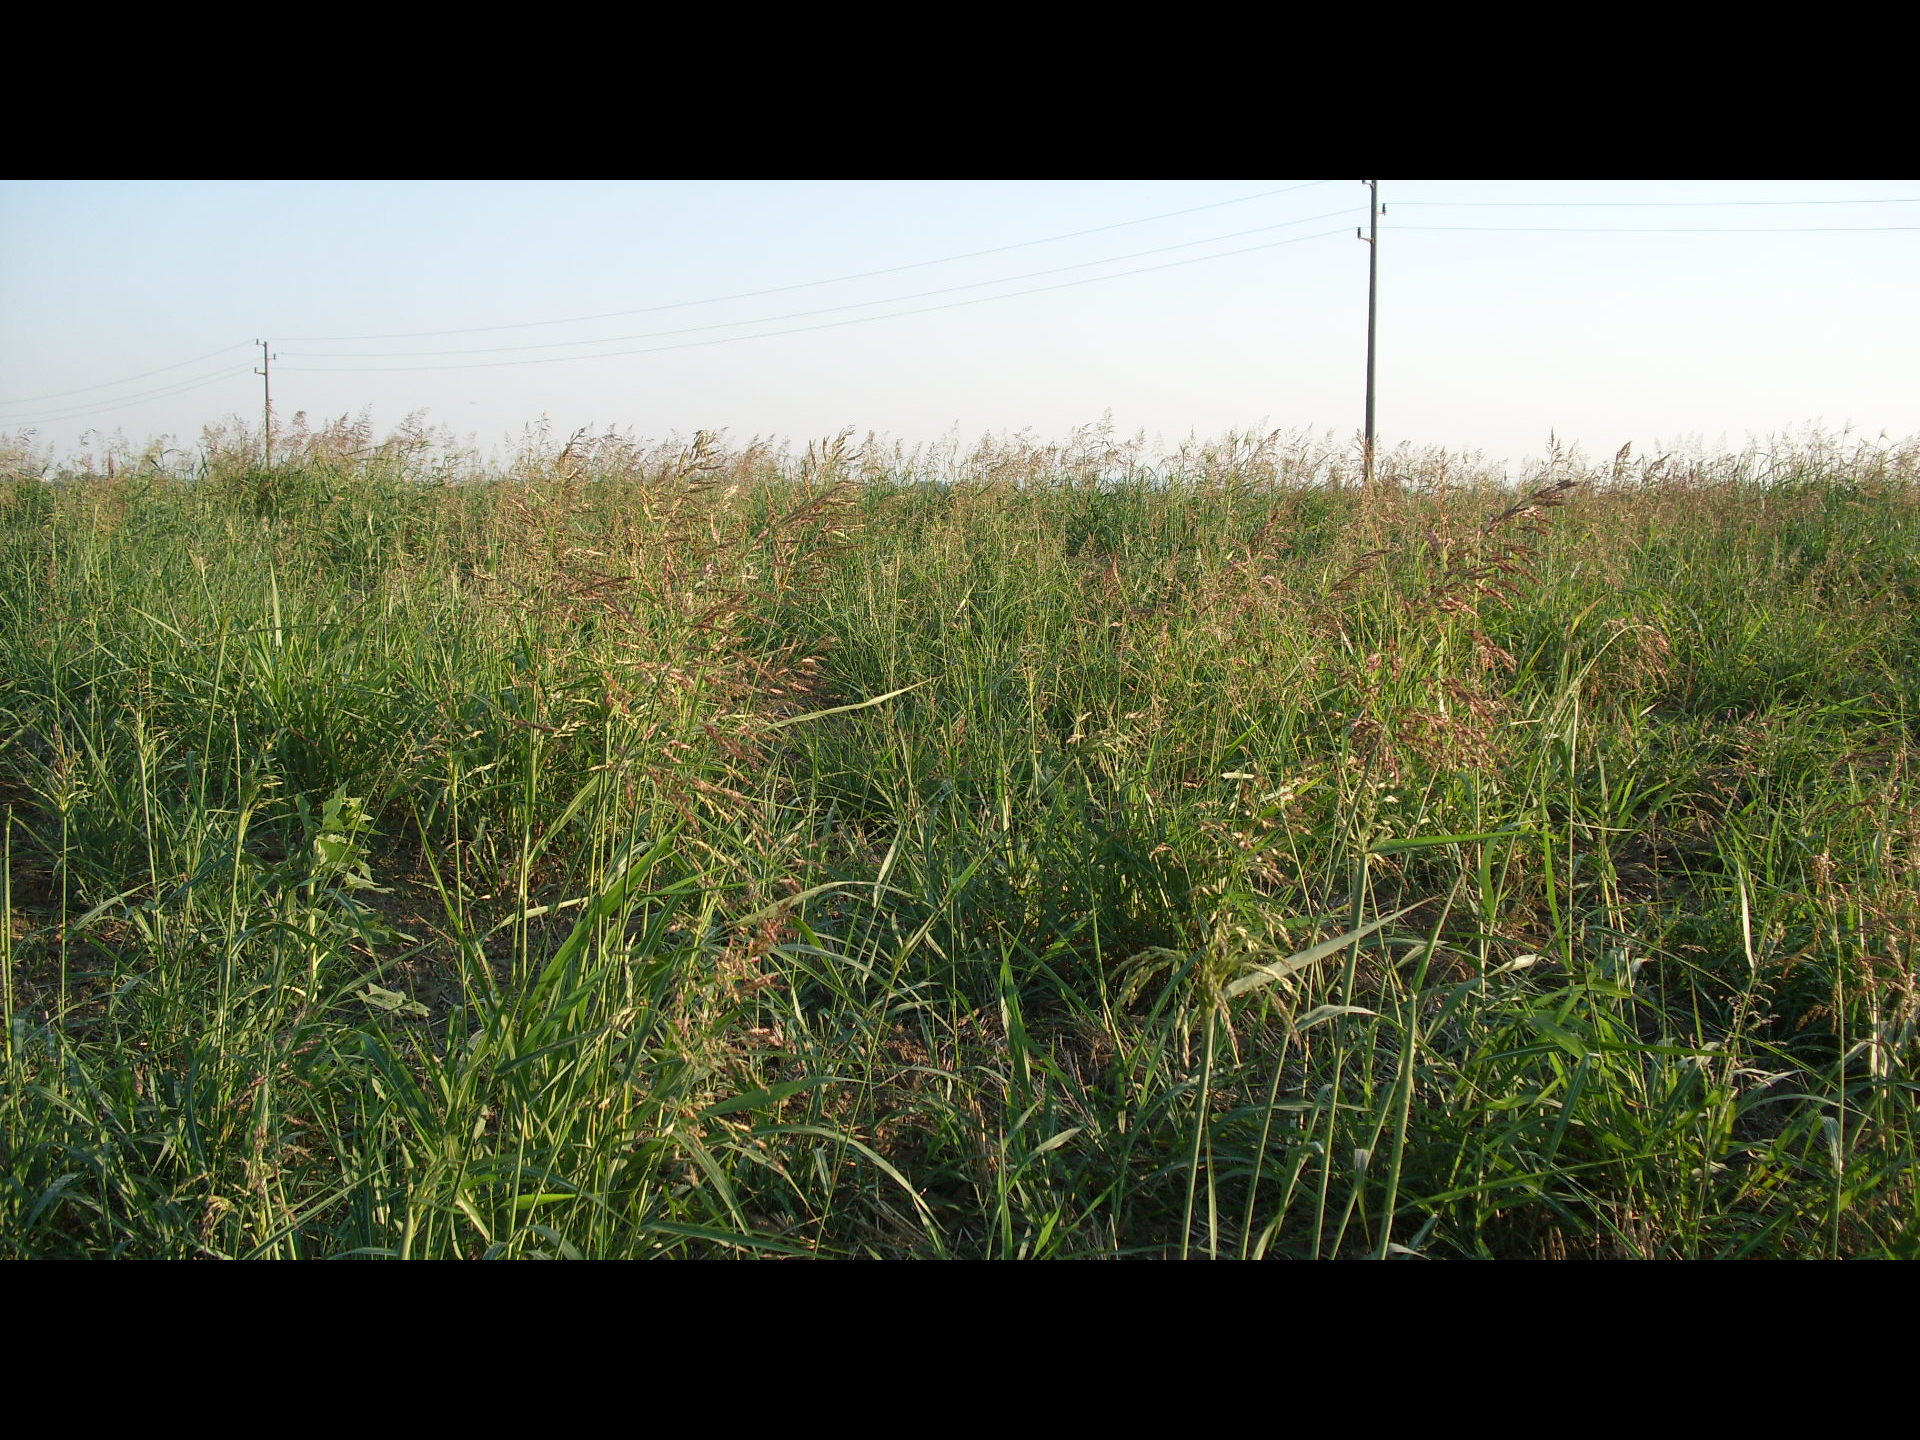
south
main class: Cropland
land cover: Common wheat
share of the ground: < 10 %
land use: Agriculture (excluding fallow land and kitchen gardens)
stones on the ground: < 10 %
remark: Harvested field
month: August
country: BG
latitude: 44.0221
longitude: 22.8518
